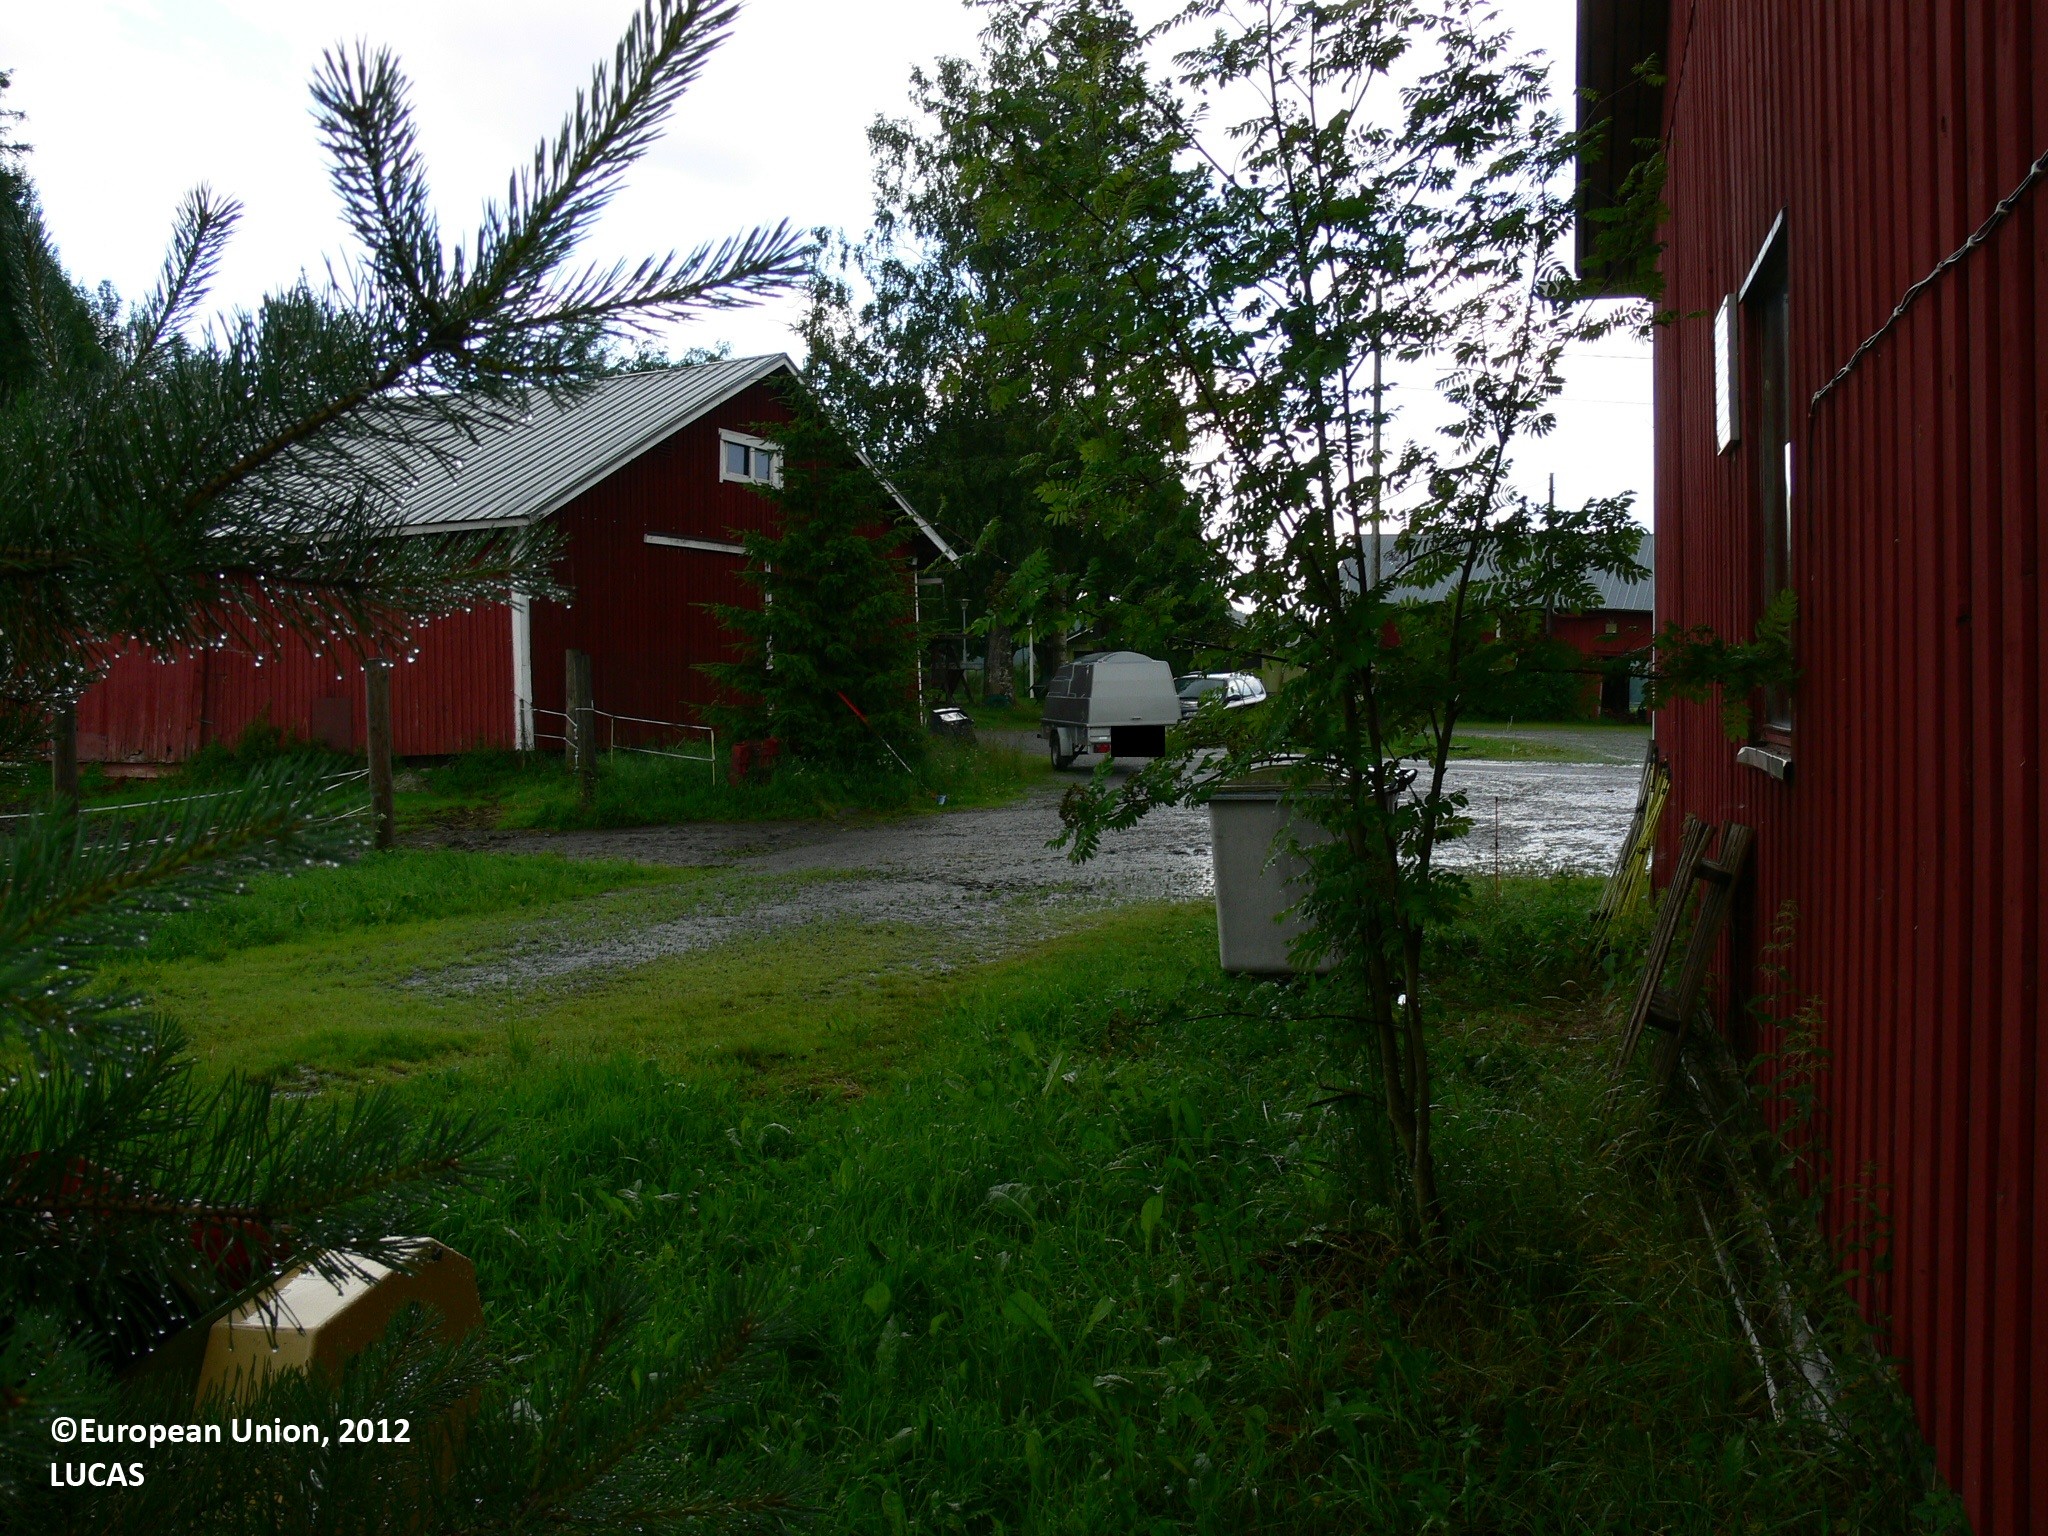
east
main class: Cropland
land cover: Temporary grasslands
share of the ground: > 75 %
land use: Agriculture (excluding fallow land and kitchen gardens)
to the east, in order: Temporary grasslands; Electric lines; Ditches and canals; Temporary grasslands; Electric lines; Ditches and canals; Temporary grasslands; Electric lines; Grassland without tree/shrub cover; Broadleaved woodland; Artificial constructions in urban areas; Inland water bodies
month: July
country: FI
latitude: 63.2654
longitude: 30.0377
